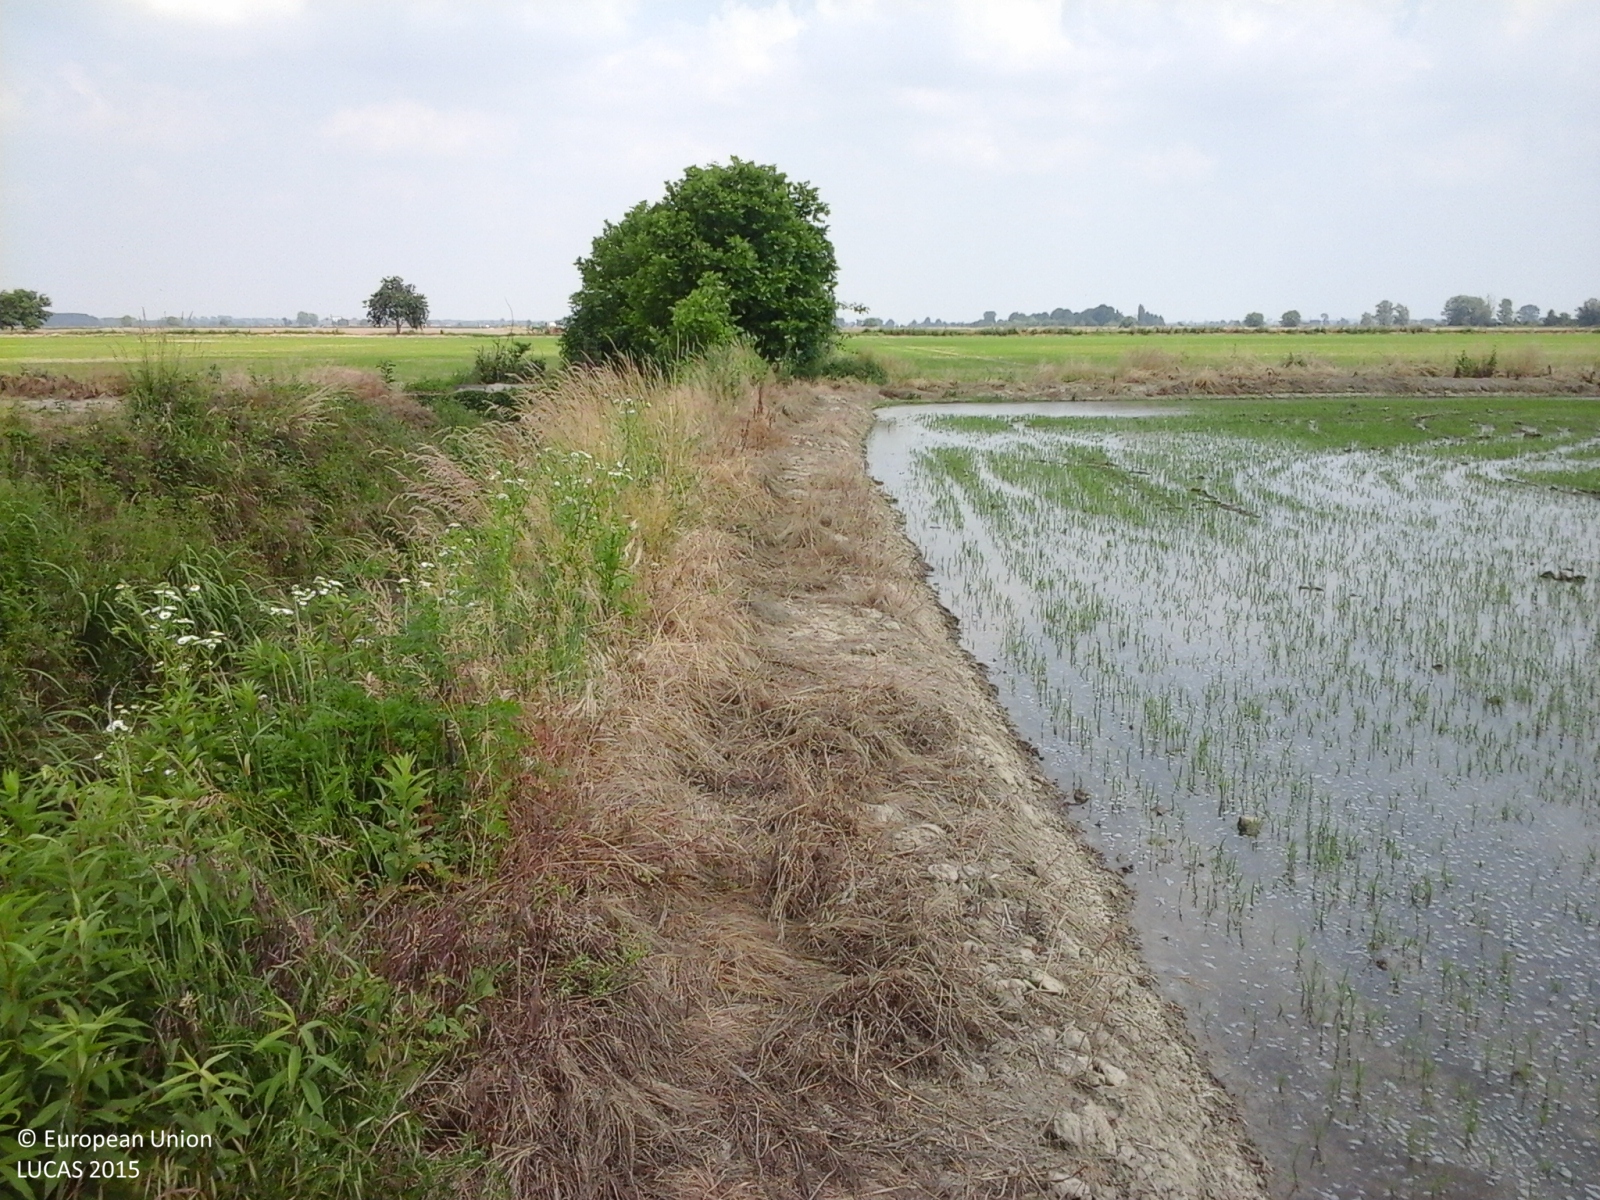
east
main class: Cropland
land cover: Rice
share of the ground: 25 - 50 %
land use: Agriculture (excluding fallow land and kitchen gardens)
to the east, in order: Rice; Grass margins; Ditches and canals; Grass margins; Rice; Ditches and canals; Rice; Ditches and canals; Rice; Ditches and canals; Rice; Ditches and canals; Rice; Grass margins; Single bushes/trees; Ditches and canals; Grass margins; Tracks; Grass margins; Other bare soil
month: May
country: IT
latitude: 45.3826
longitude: 8.3043
